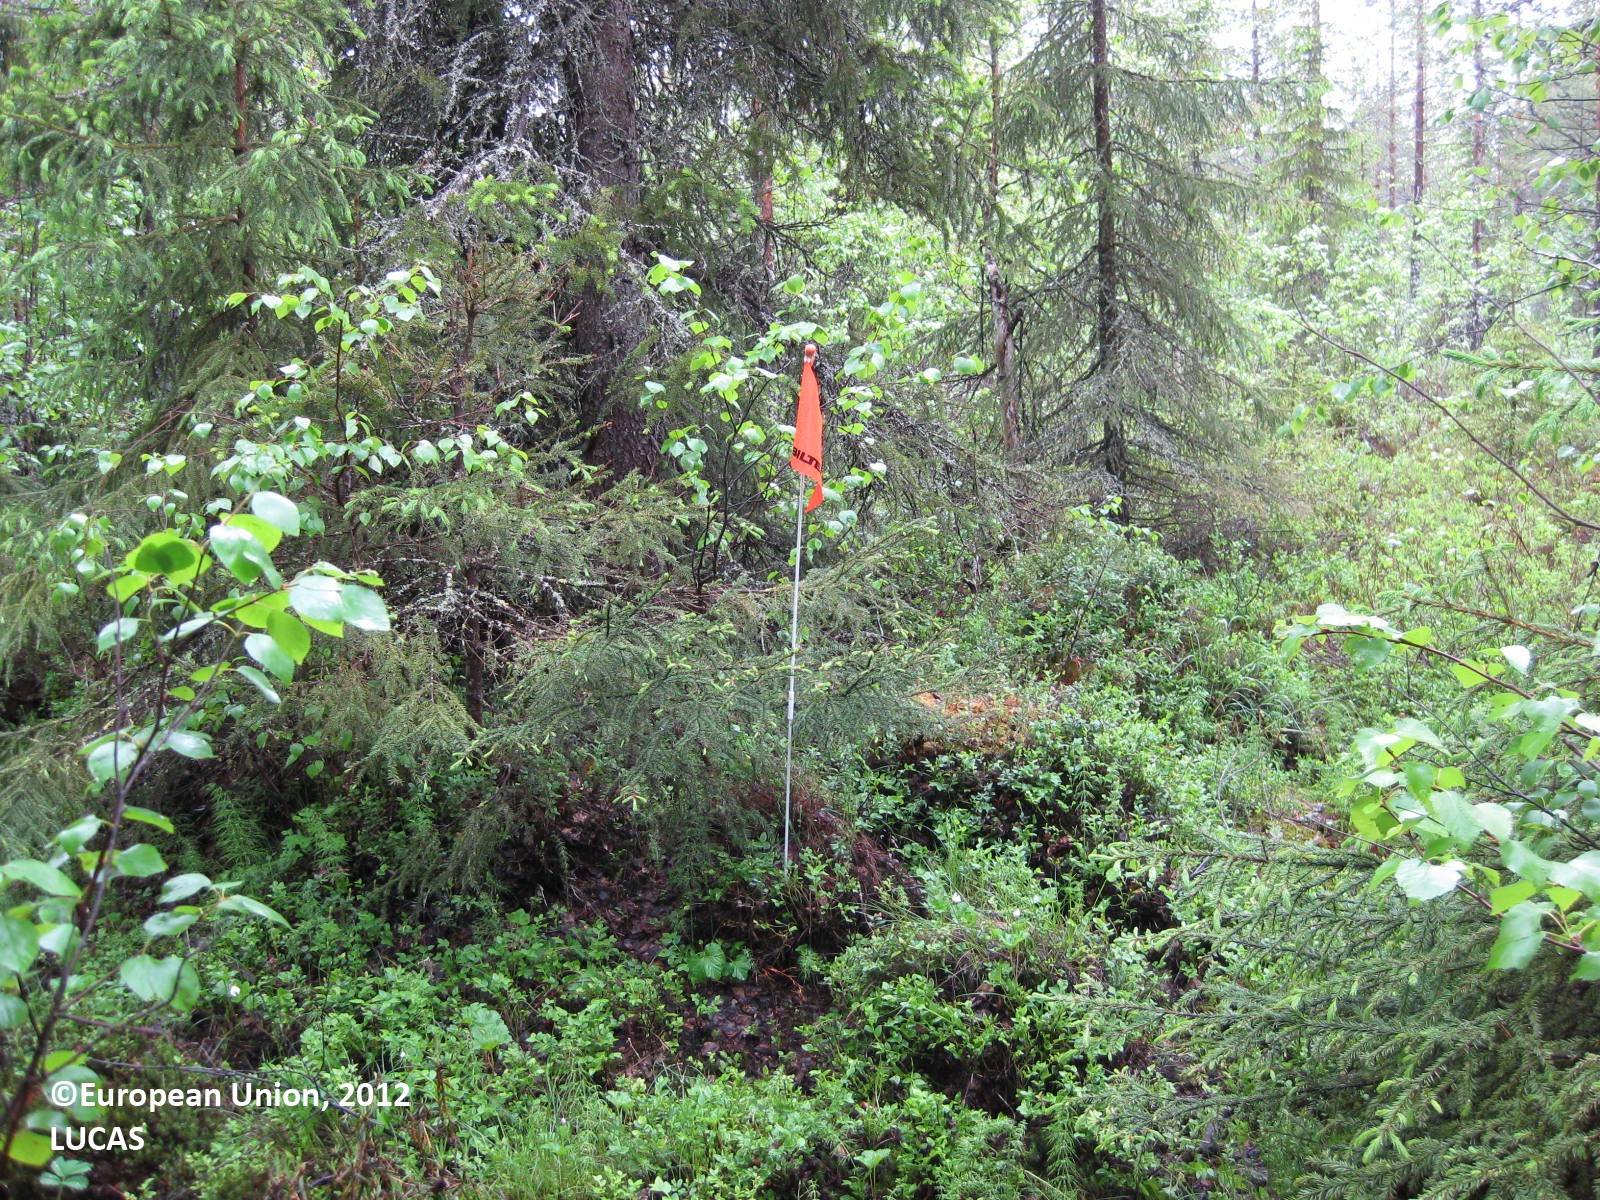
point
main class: Woodland
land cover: Other mixed woodland
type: boreal forest
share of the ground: > 75 %
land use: Forestry
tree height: > 5 m
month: June
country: FI
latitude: 65.0837
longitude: 29.0129
